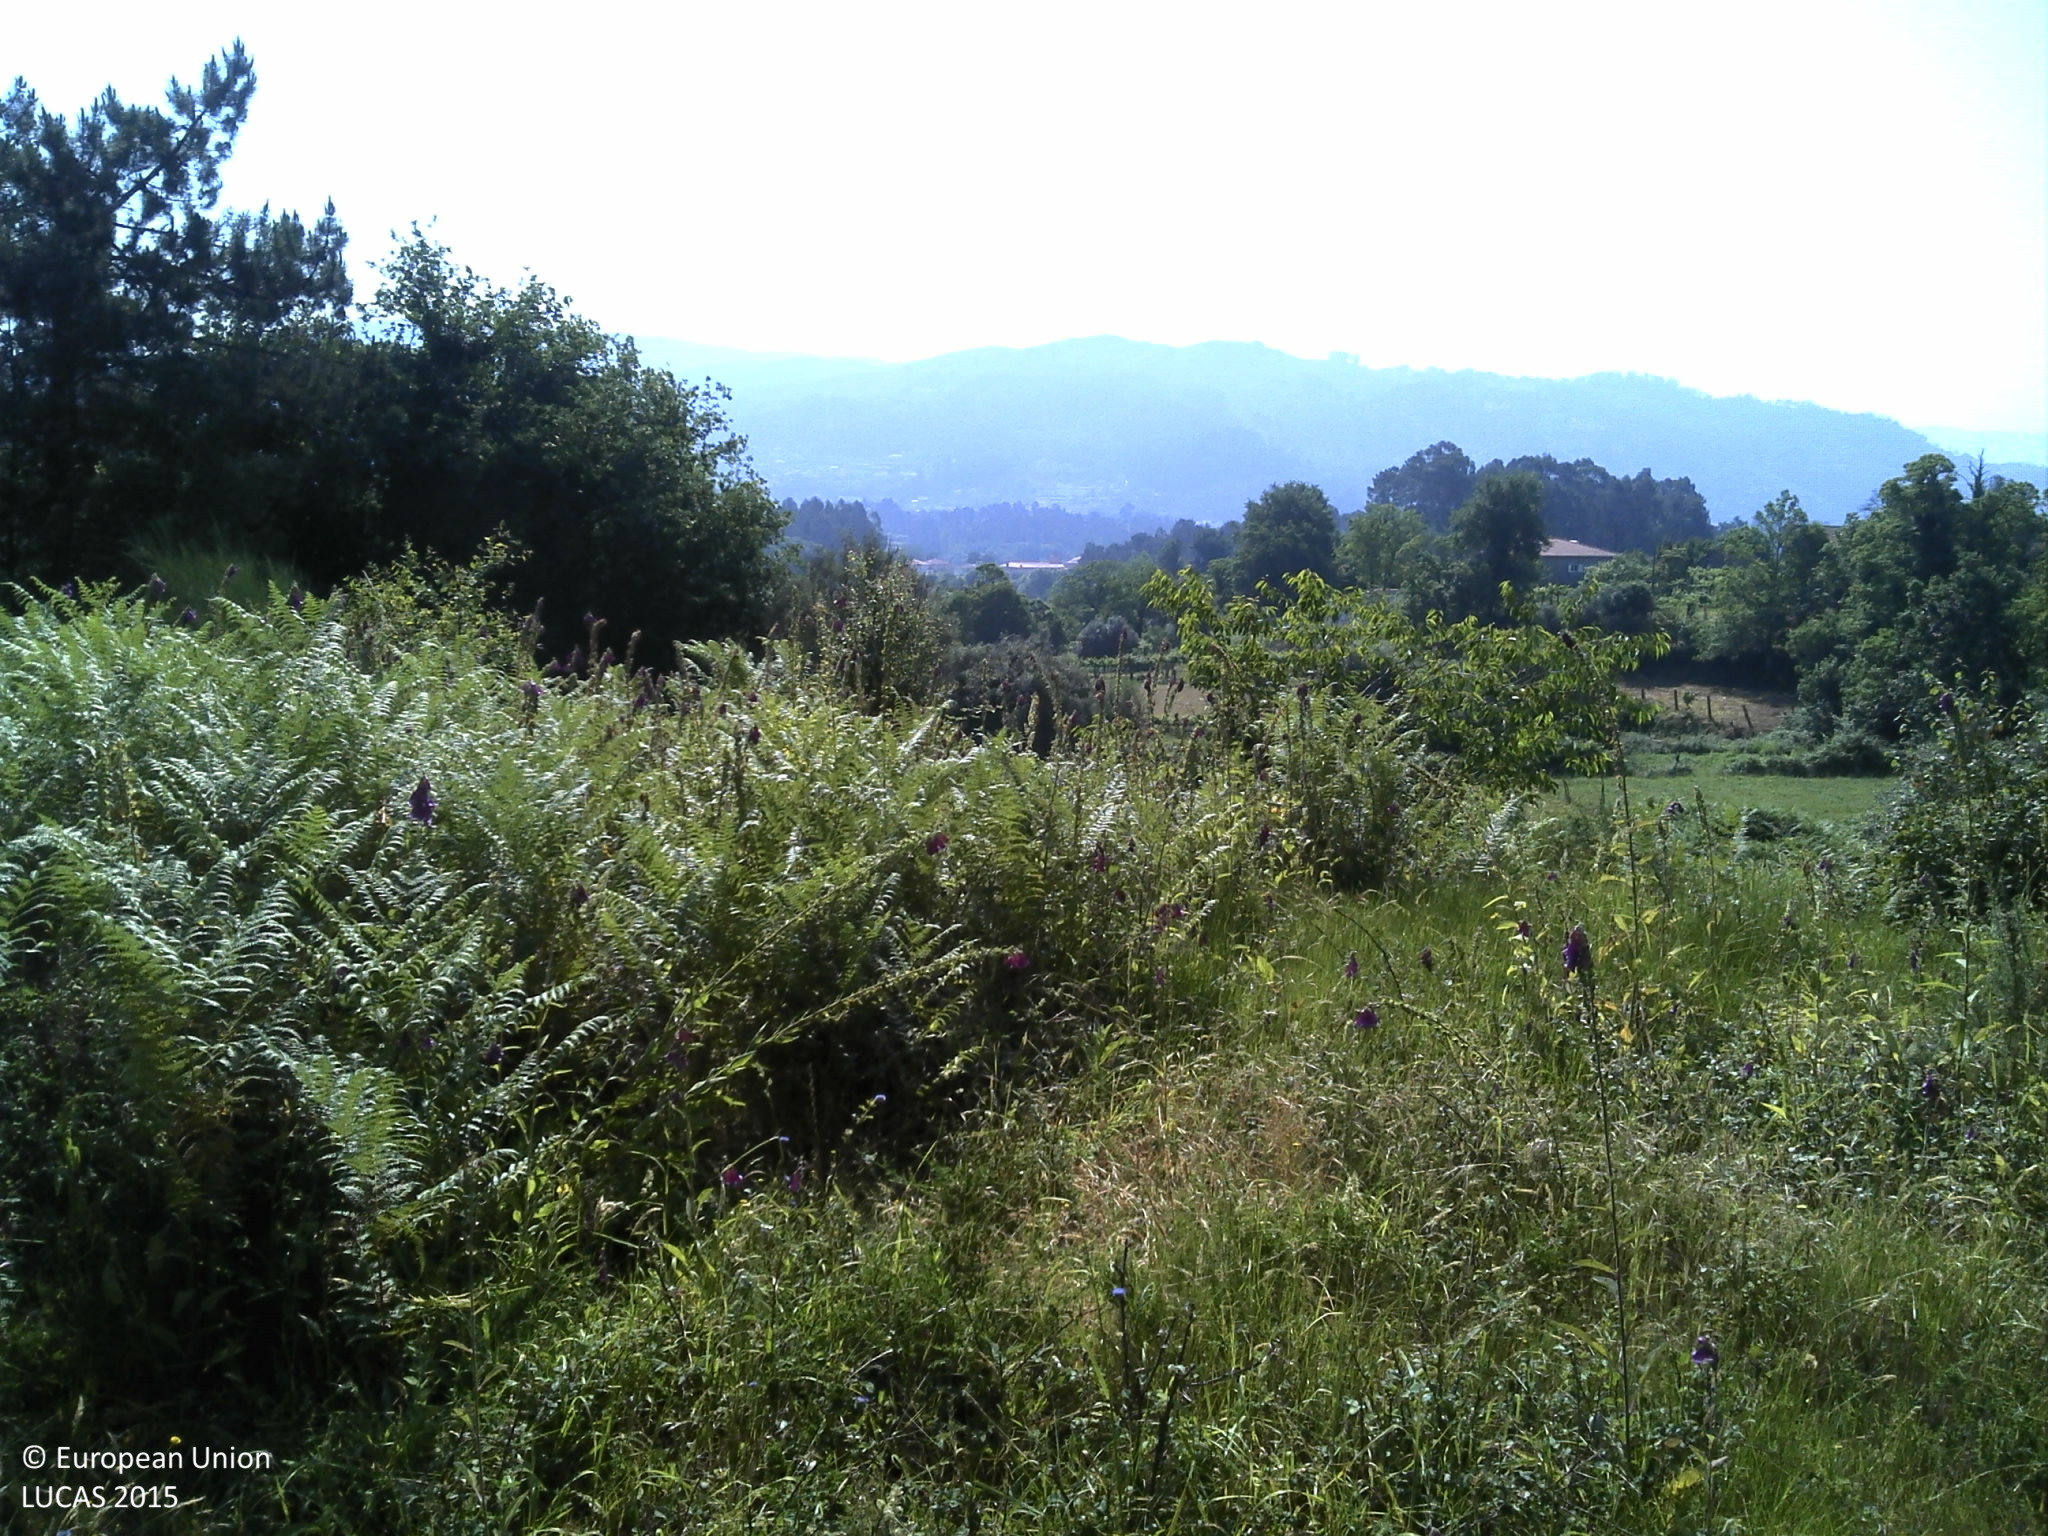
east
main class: Grassland
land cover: Grassland with sparse tree/shrub cover
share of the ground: 50 - 75 %
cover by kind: herbaceous plants 75 %, shrubs 10 %, unconsolidated bare surface 10 %, broadleaved forest trees 5 %
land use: Agriculture (excluding fallow land and kitchen gardens)
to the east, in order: Grassland with sparse tree/shrub cover; Dry stone walls; Tracks; Shrubland without tree cover; Paved roads, cycling and walking lanes; Artificial constructions; Broadleaved woodland; Grassland without tree/shrub cover; Fences; Grassland without tree/shrub cover; Vineyards; Grassland without tree/shrub cover; Single bushes/trees; Shrubland without tree cover; Grassland without tree/shrub cover; Fences; Vineyards; Maize
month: June
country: PT
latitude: 41.8681
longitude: -8.4361
